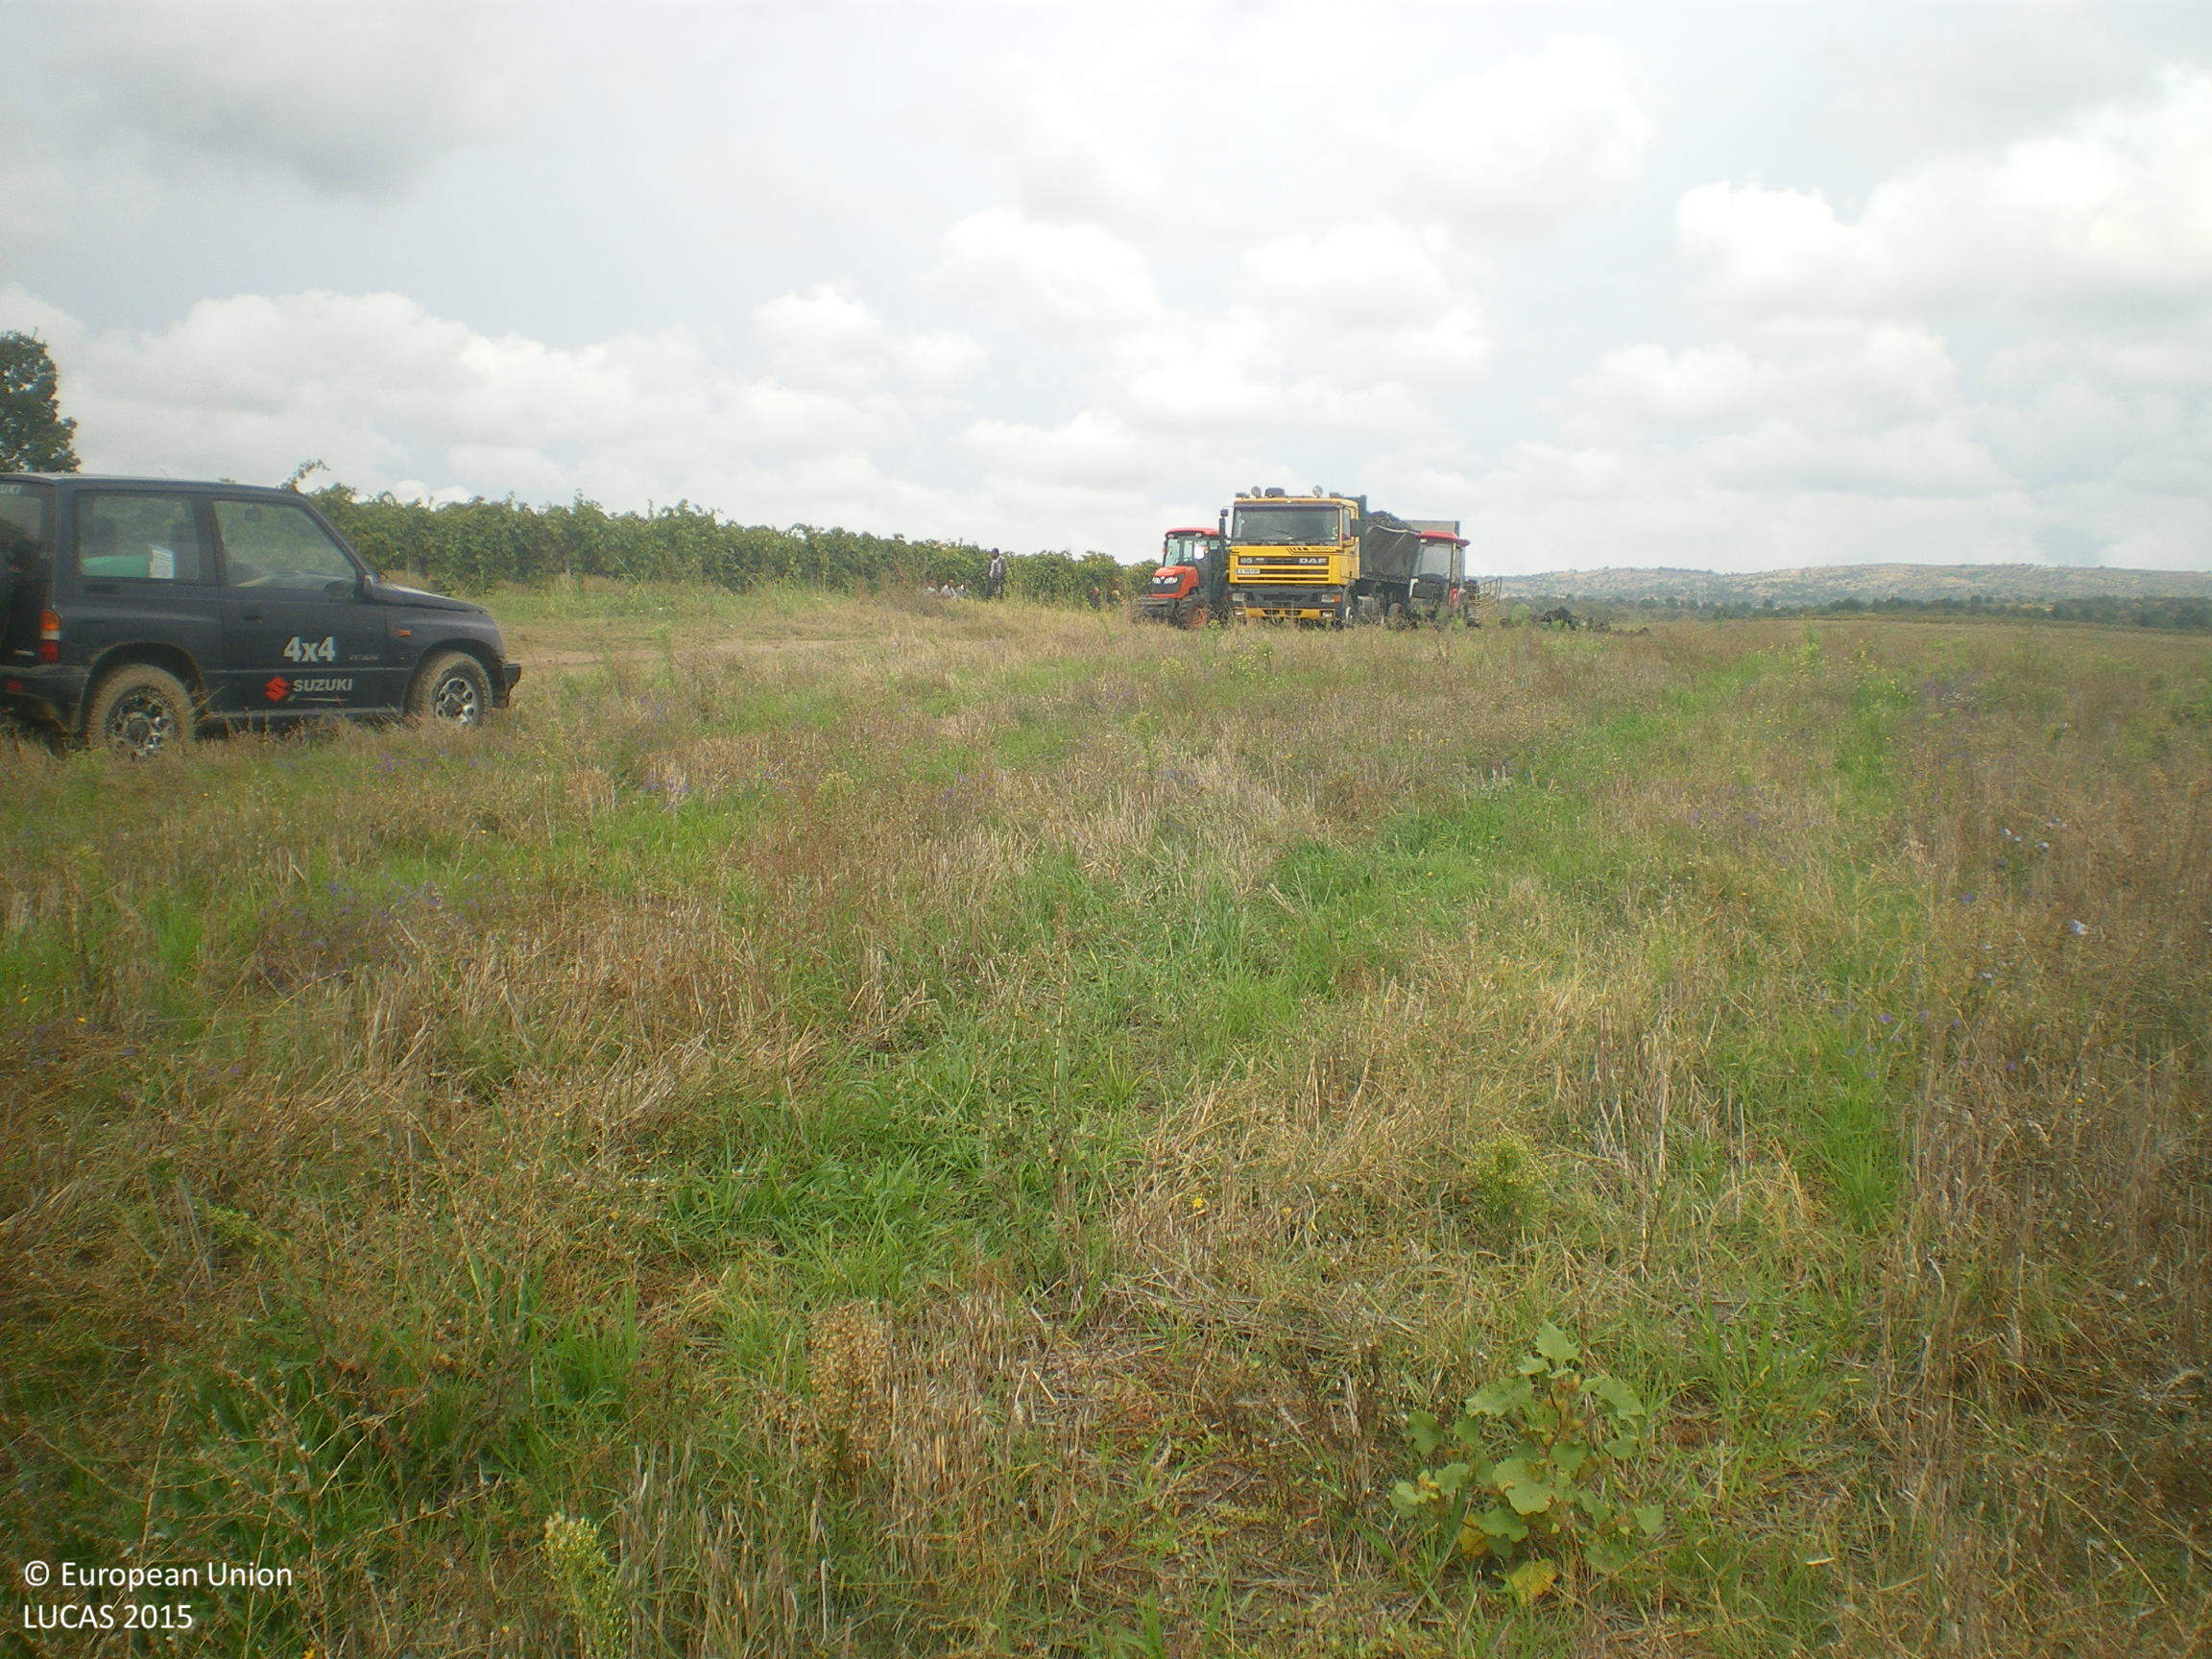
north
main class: Cropland
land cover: Common wheat
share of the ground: < 10 %
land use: Agriculture (excluding fallow land and kitchen gardens)
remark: Harvested field
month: October
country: BG
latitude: 41.9509
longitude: 26.0593
